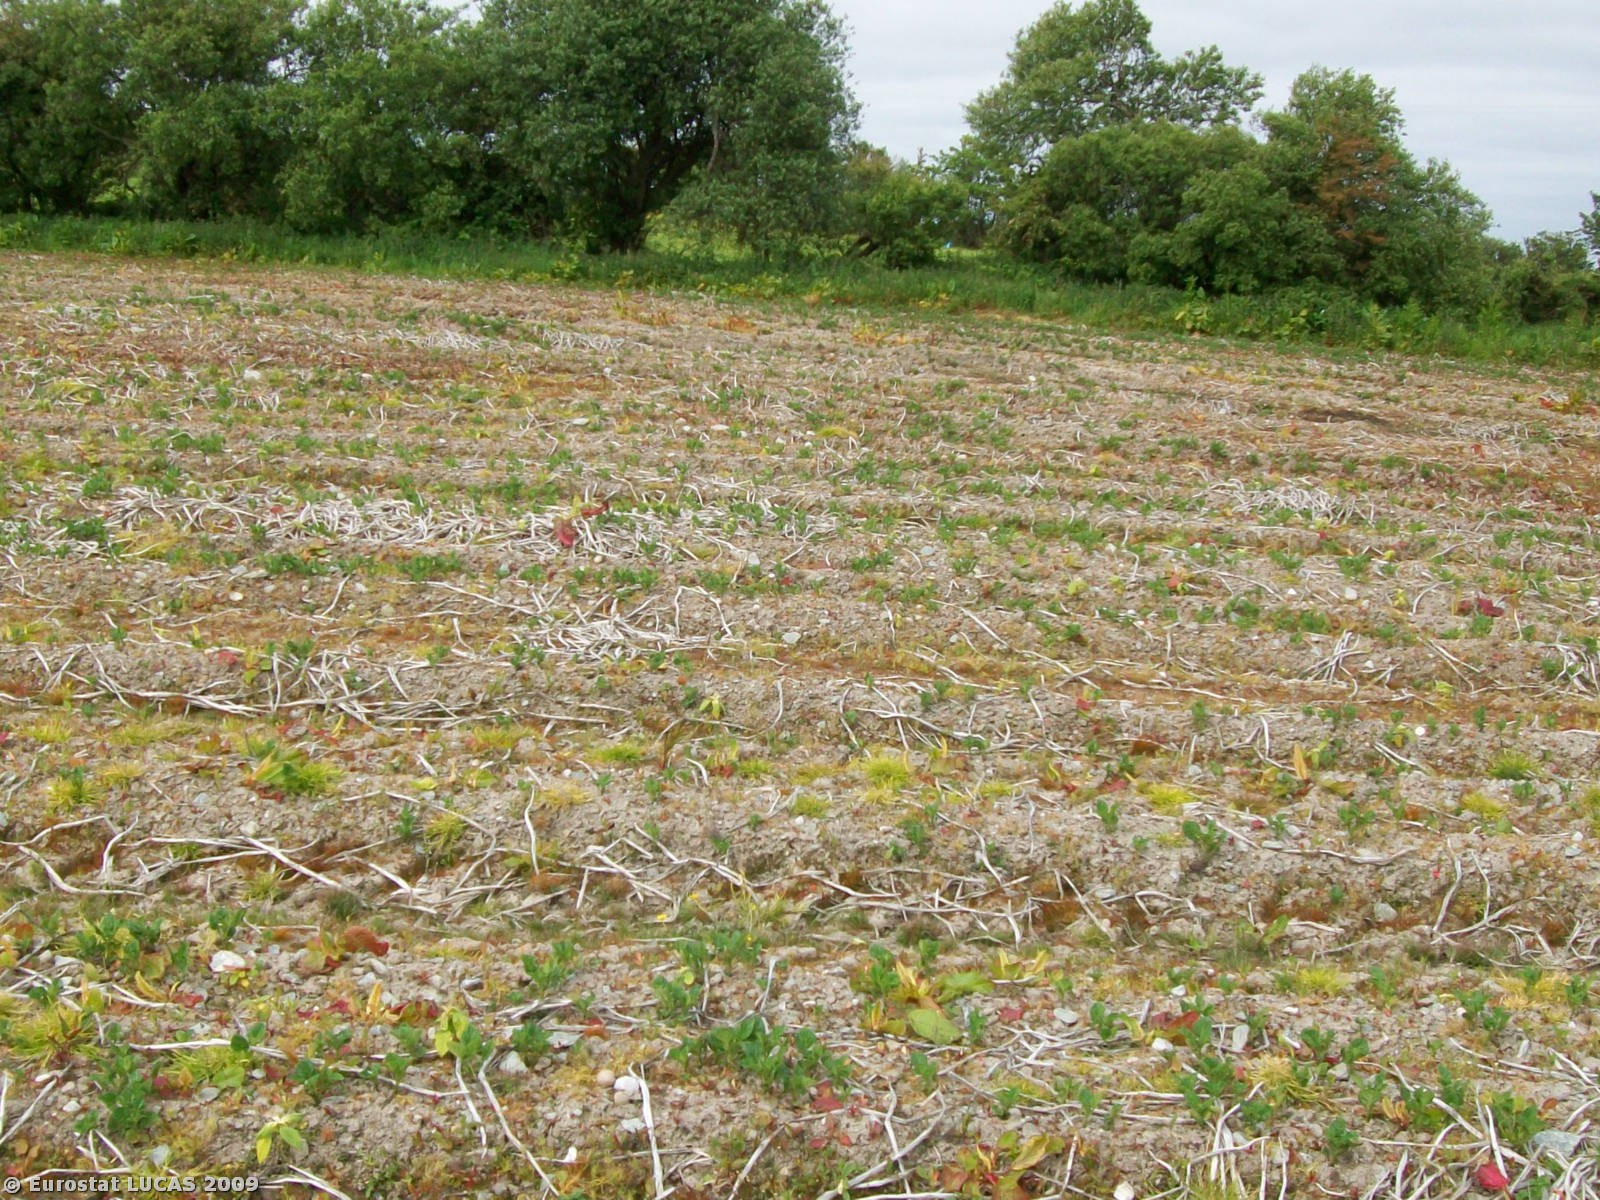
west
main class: Cropland
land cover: Potatoes
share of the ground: > 75 %
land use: Agriculture (excluding fallow land and kitchen gardens)
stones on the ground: < 10 %
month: June
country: GB
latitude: 55.0289
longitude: -7.0831
